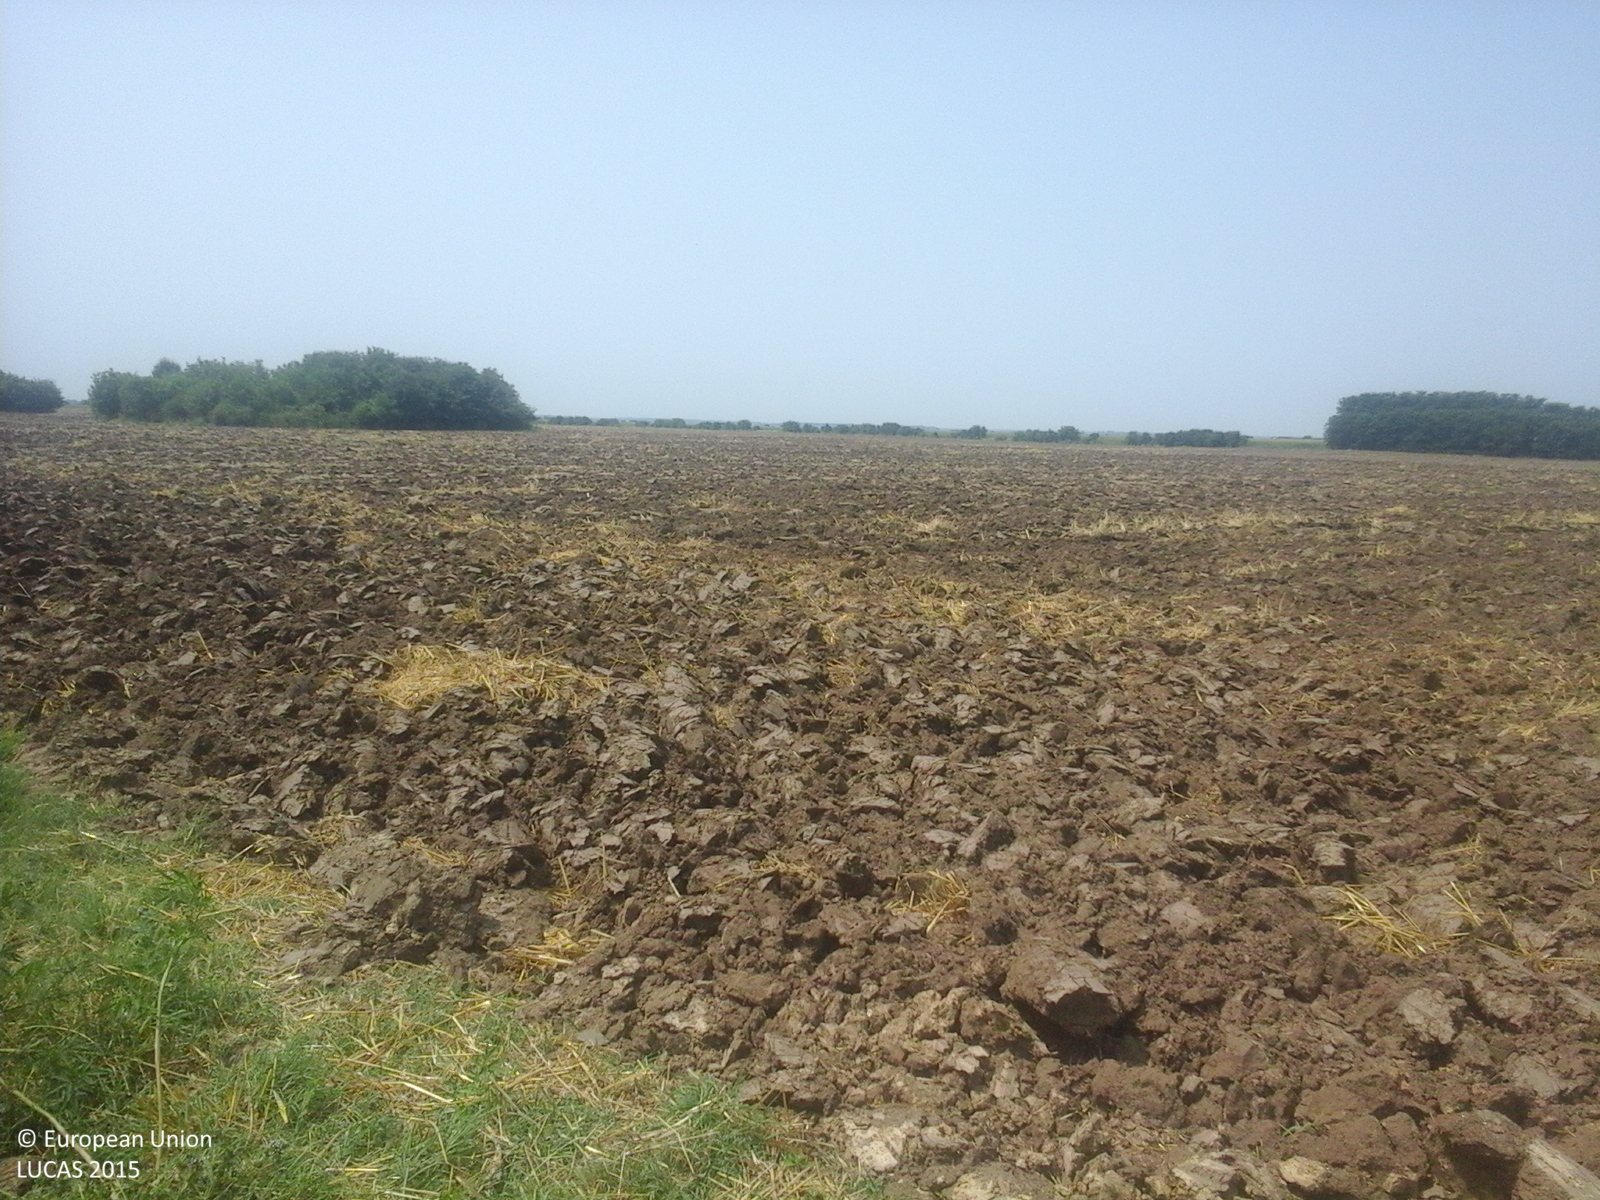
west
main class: Cropland
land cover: Lucerne
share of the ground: > 75 %
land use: Agriculture (excluding fallow land and kitchen gardens)
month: July
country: RO
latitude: 44.7698
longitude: 26.3511
